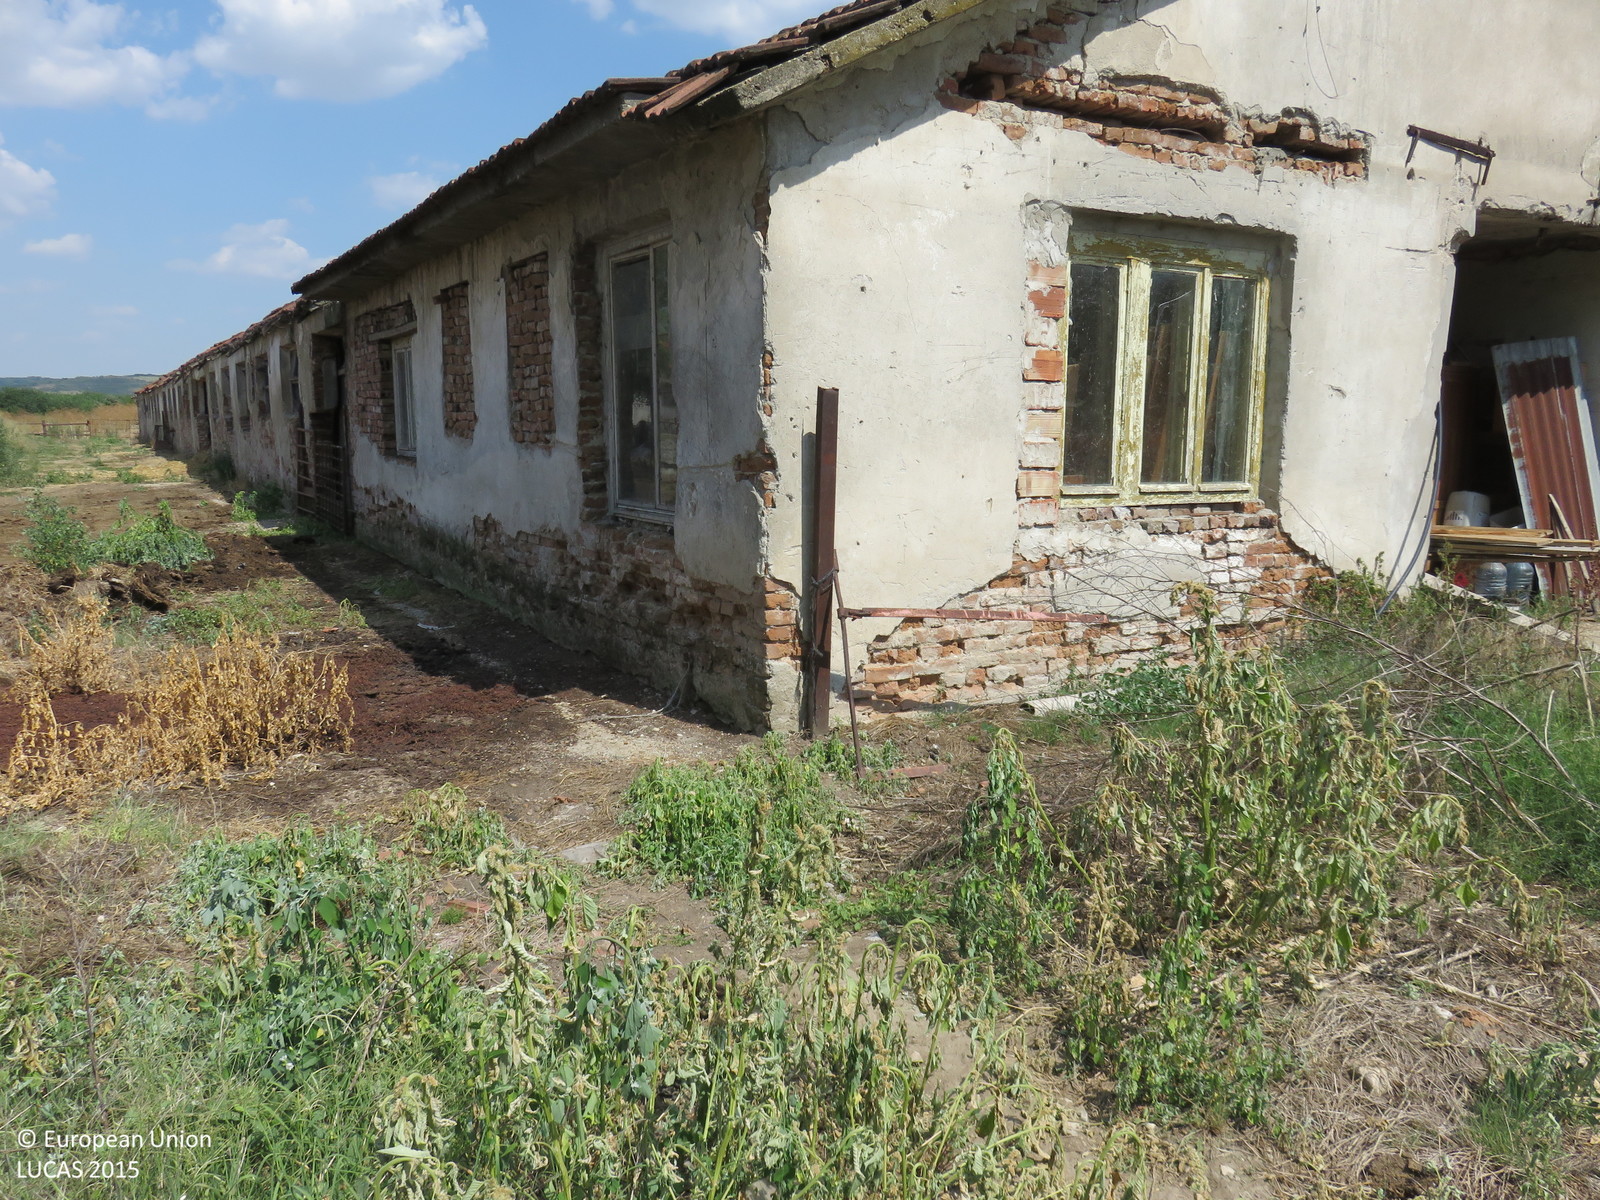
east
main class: Grassland
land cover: Spontaneously vegetated surfaces
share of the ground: > 75 %
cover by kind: herbaceous plants 90 %, unconsolidated bare surface 10 %
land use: Agriculture (excluding fallow land and kitchen gardens)
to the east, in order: Spontaneously vegetated surfaces; Artificial constructions in urban areas; Spontaneously vegetated surfaces; Tracks; Grassland without tree/shrub cover; Tracks; Grassland without tree/shrub cover; Electric lines; Grassland without tree/shrub cover
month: July
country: BG
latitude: 43.4207
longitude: 25.1040
